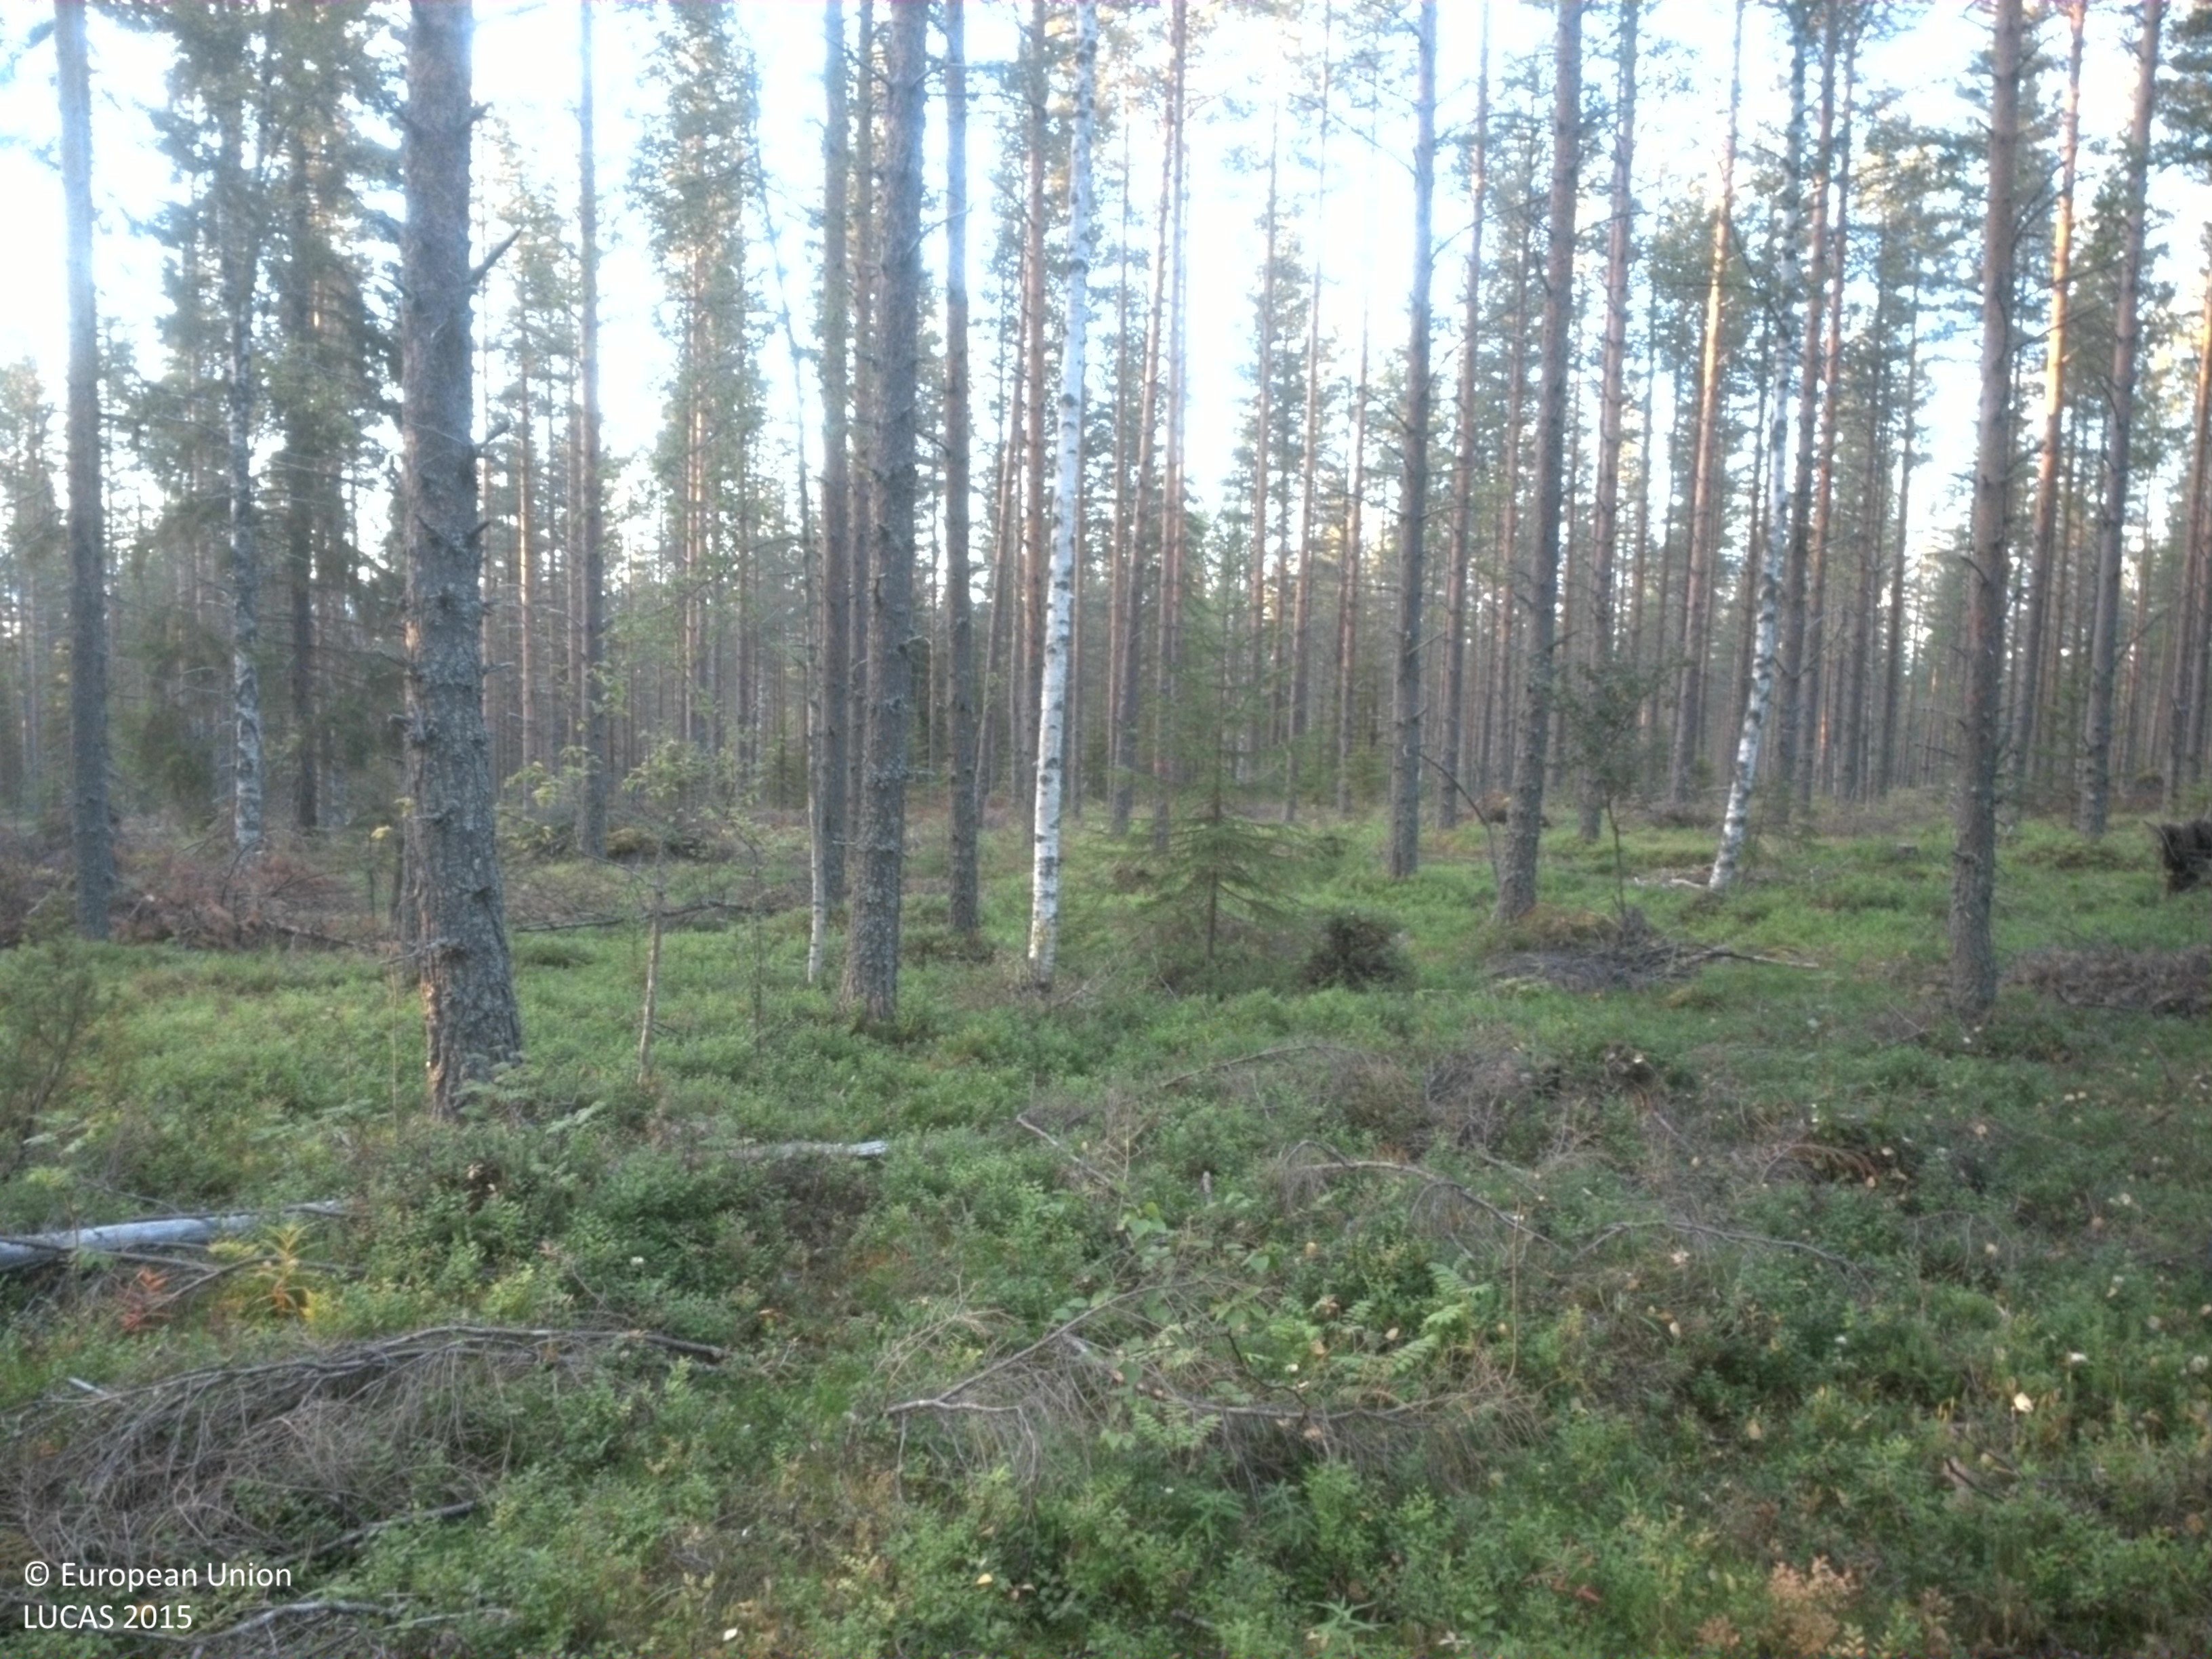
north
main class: Woodland
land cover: Pine dominated coniferous woodland
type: boreal forest
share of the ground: 25 - 50 %
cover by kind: coniferous forest trees 45 %, shrubs 45 %, broadleaved forest trees 5 %, lichens and mosses 5 %
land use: Forestry
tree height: > 5 m
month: September
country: SE
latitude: 64.3566
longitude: 19.6867
